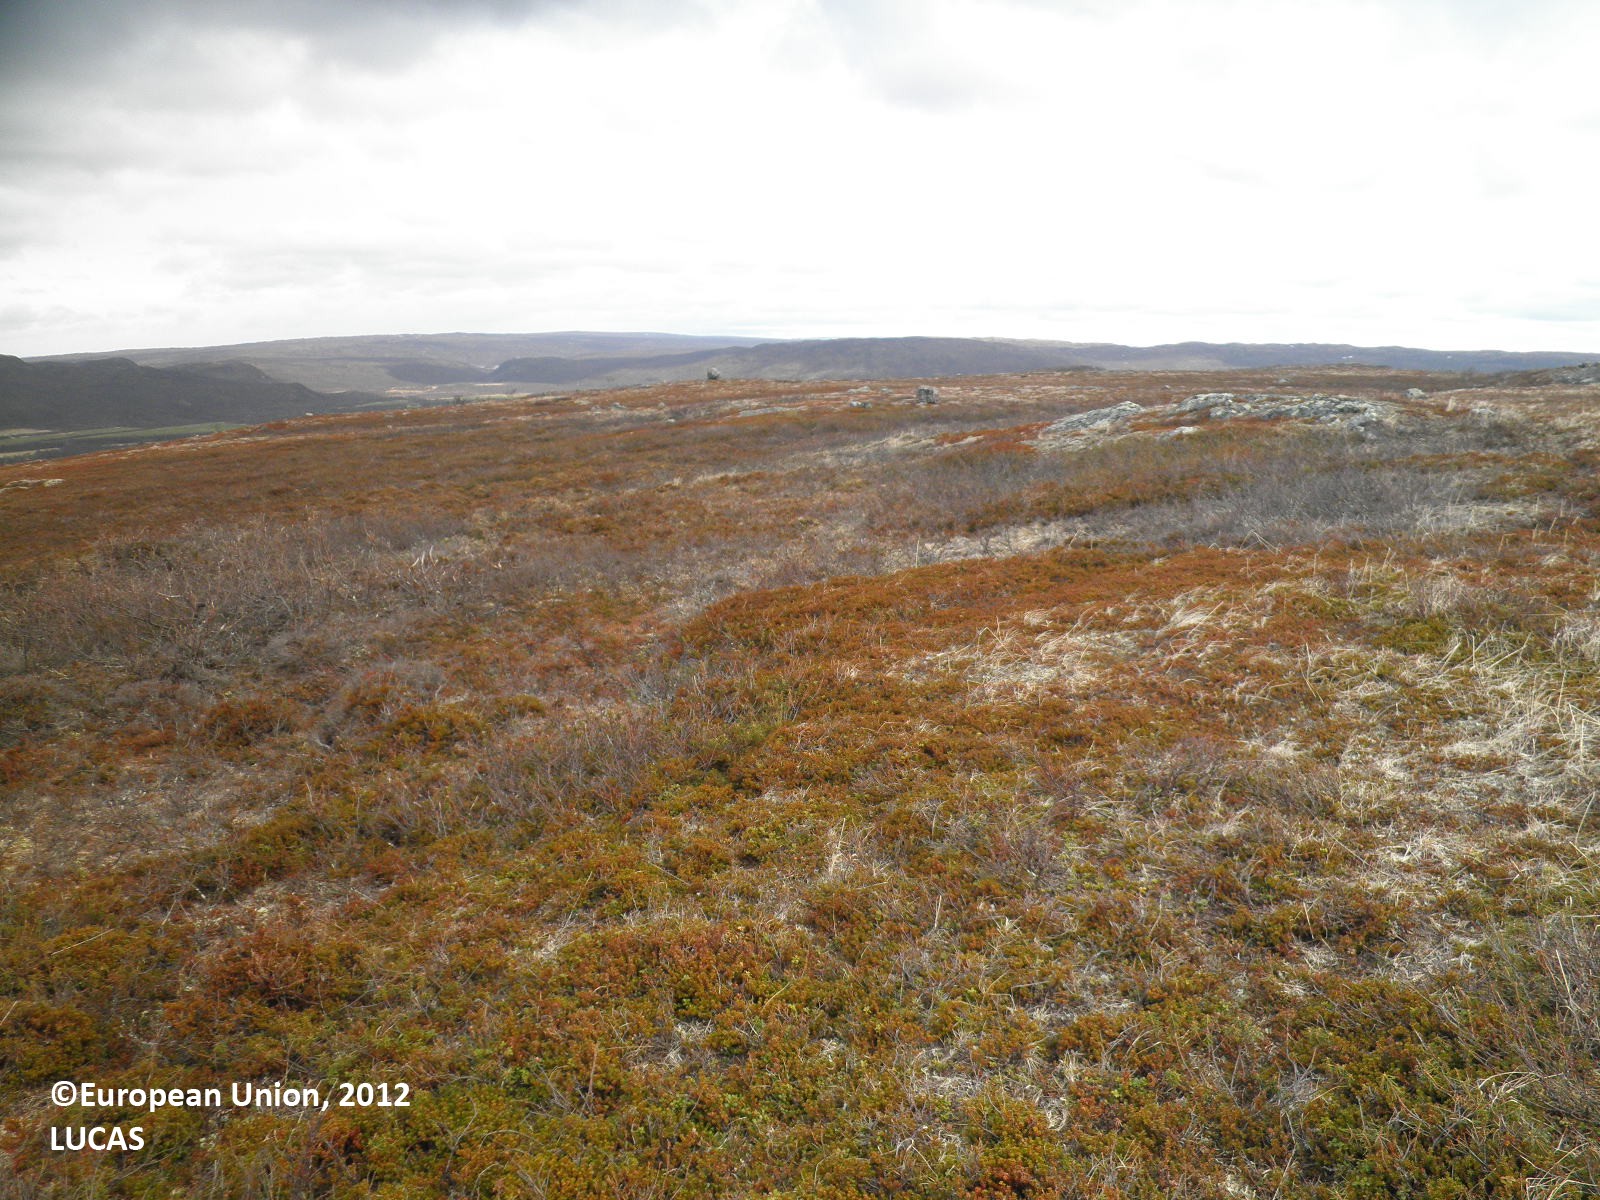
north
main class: Shrubland
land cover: Shrubland without tree cover
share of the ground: > 75 %
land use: Semi-natural and natural areas not in use
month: May
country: FI
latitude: 70.0667
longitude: 27.9062
